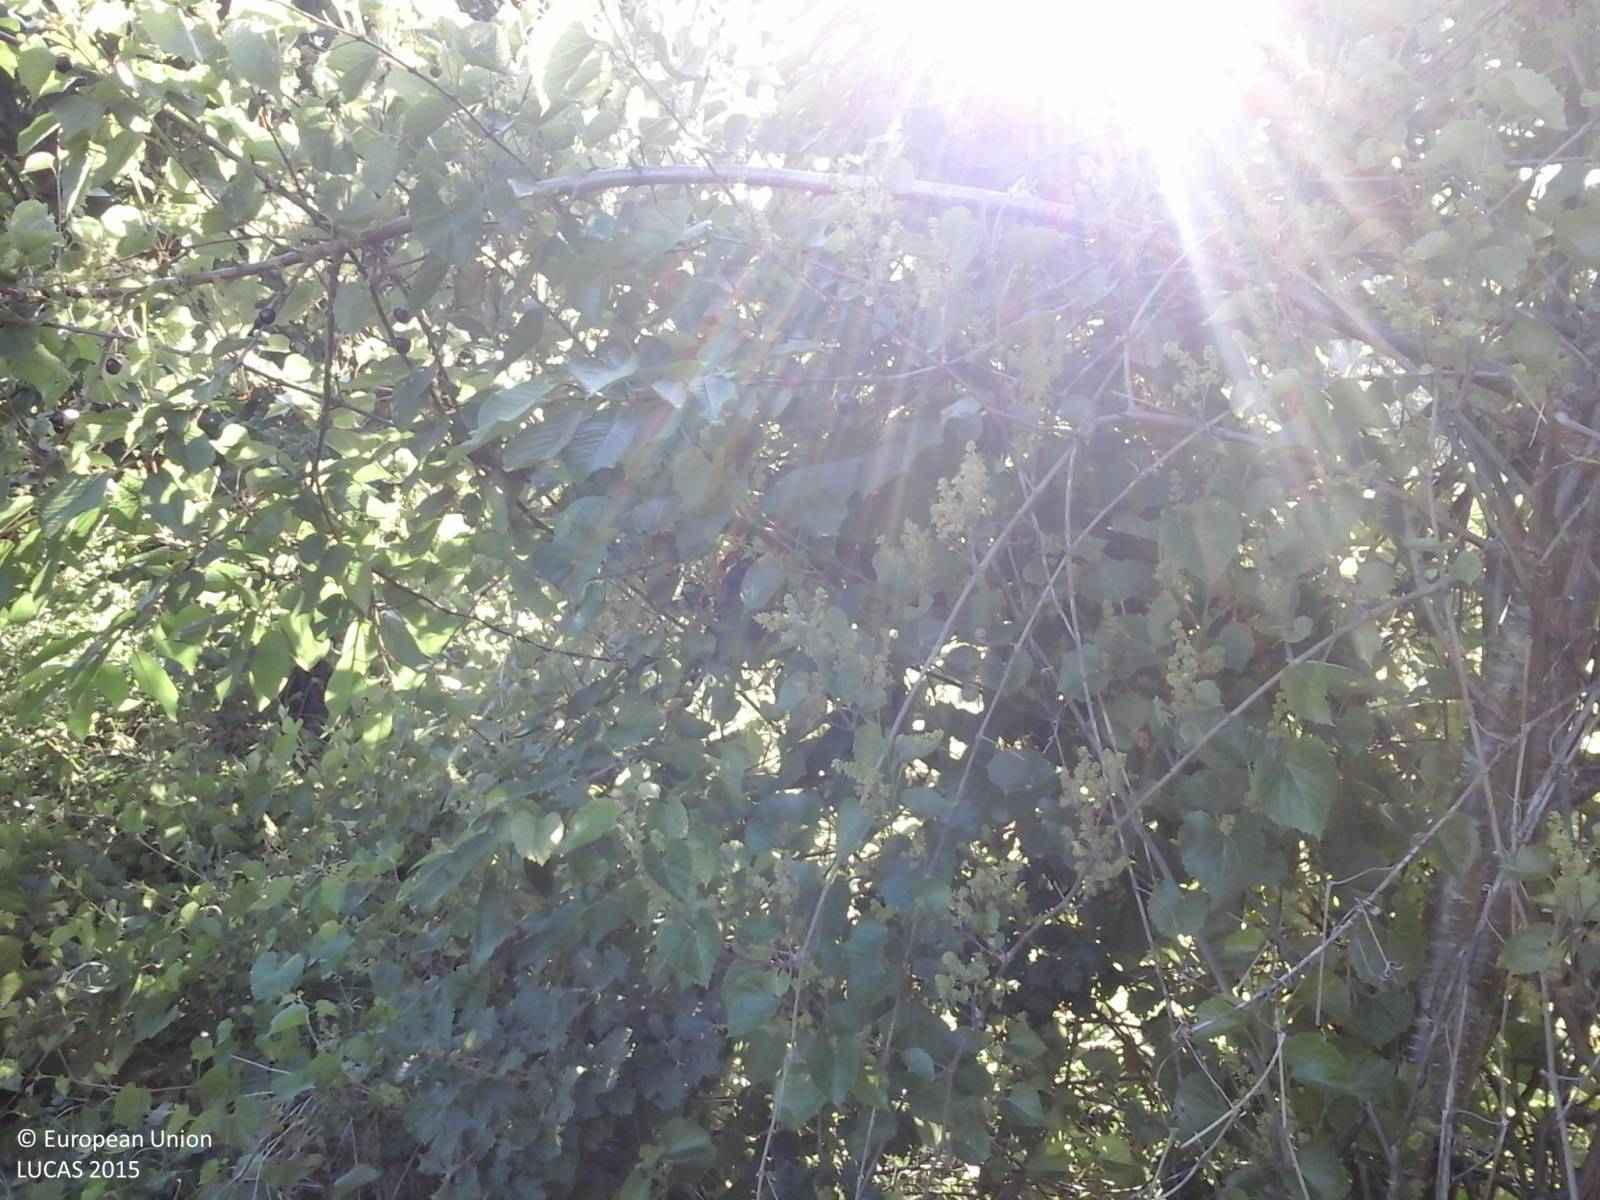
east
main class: Shrubland
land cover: Shrubland with sparse tree cover
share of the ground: > 75 %
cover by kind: shrubs 95 %, broadleaved forest trees 5 %
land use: Abandoned areas
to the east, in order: Shrubland with sparse tree cover; Oats; Fences; Other fruit trees and berries; Fences; Other leguminous and mixtures for fodder; Shrubland with sparse tree cover; Vineyards; Broadleaved woodland; Fences; Broadleaved woodland; Fences; Broadleaved woodland; Permanent crops (only in case pi)
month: June
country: IT
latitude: 42.0775
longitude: 13.7708
